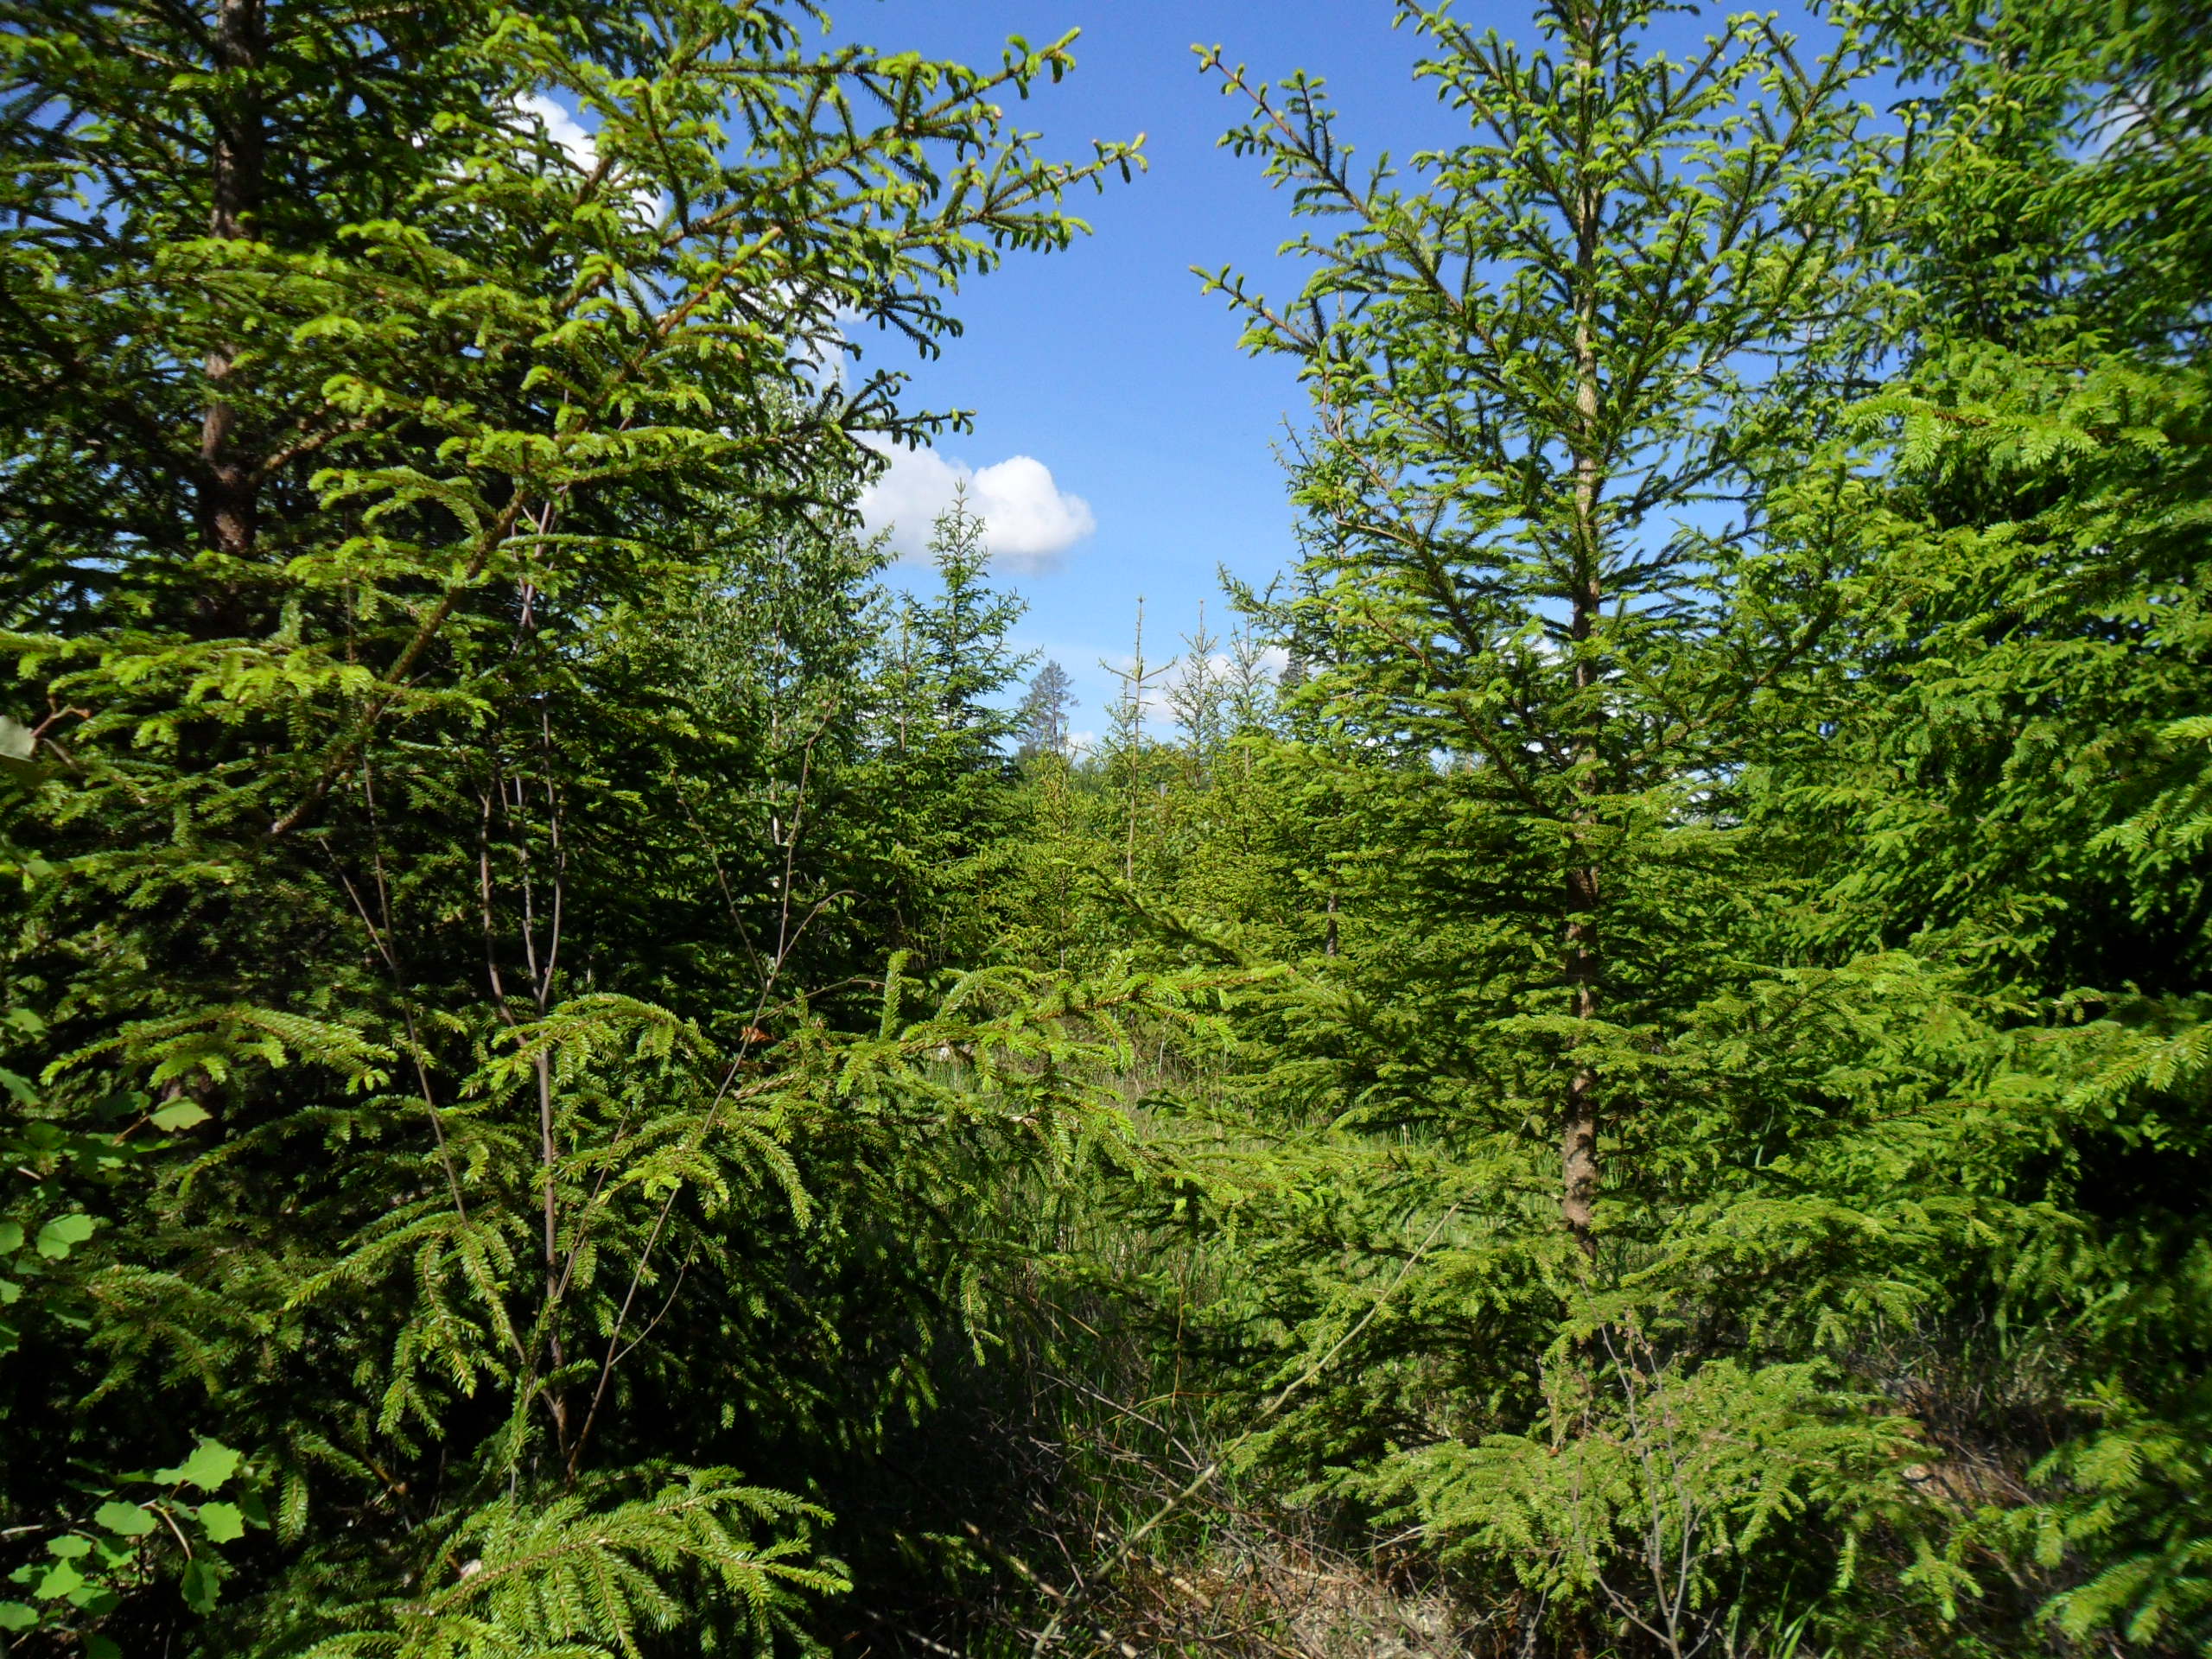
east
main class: Woodland
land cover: Spruce dominated coniferous woodland
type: hemiboreal forest and nemoral coniferous forest and mixed broadleaved-coniferous forest
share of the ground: 50 - 75 %
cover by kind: coniferous forest trees 65 %, shrubs 15 %, herbaceous plants 15 %, broadleaved forest trees 5 %
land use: Forestry
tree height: < 5 m
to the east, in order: Spruce dominated coniferous woodland; Spruce dominated mixed woodland; Tracks; Spruce dominated mixed woodland; Spruce dominated coniferous woodland; Shrubland with sparse tree cover
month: June
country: LV
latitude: 57.4890
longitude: 22.4807
